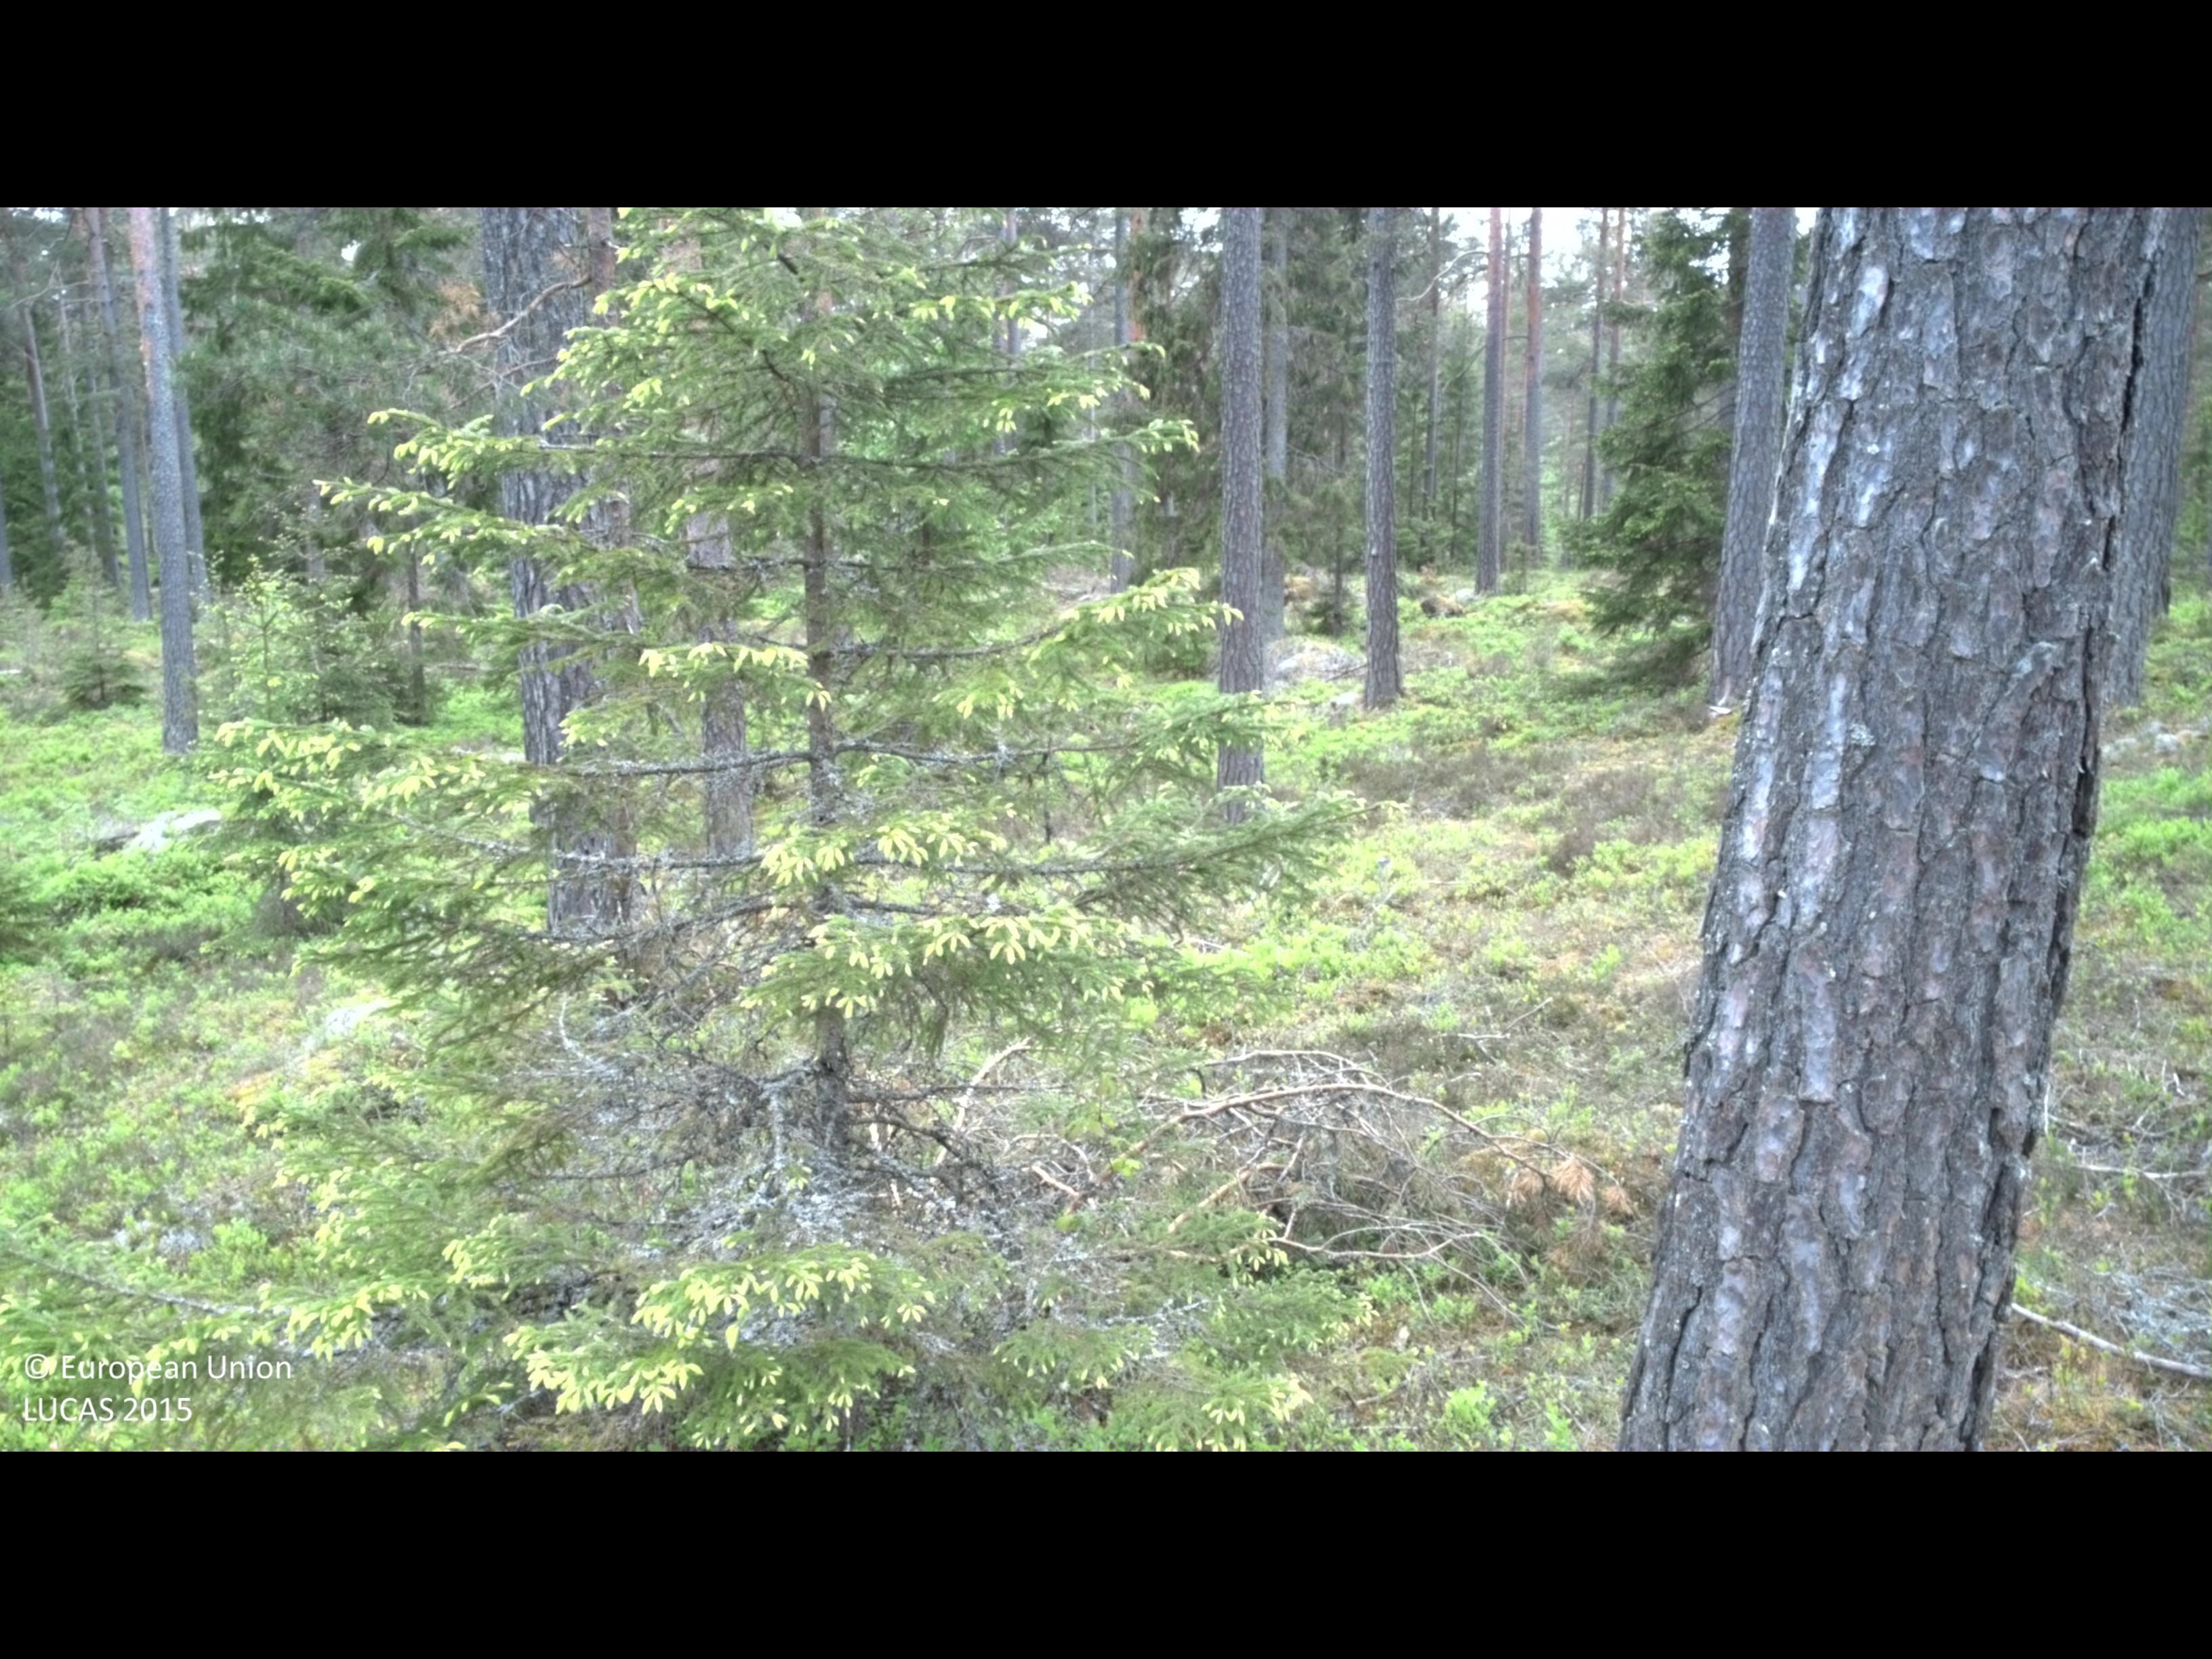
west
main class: Woodland
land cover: Pine dominated coniferous woodland
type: boreal forest
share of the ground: 50 - 75 %
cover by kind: coniferous forest trees 60 %, shrubs 30 %, broadleaved forest trees 5 %, lichens and mosses 5 %
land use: Forestry
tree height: > 5 m
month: May
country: SE
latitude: 57.4295
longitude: 16.1441
